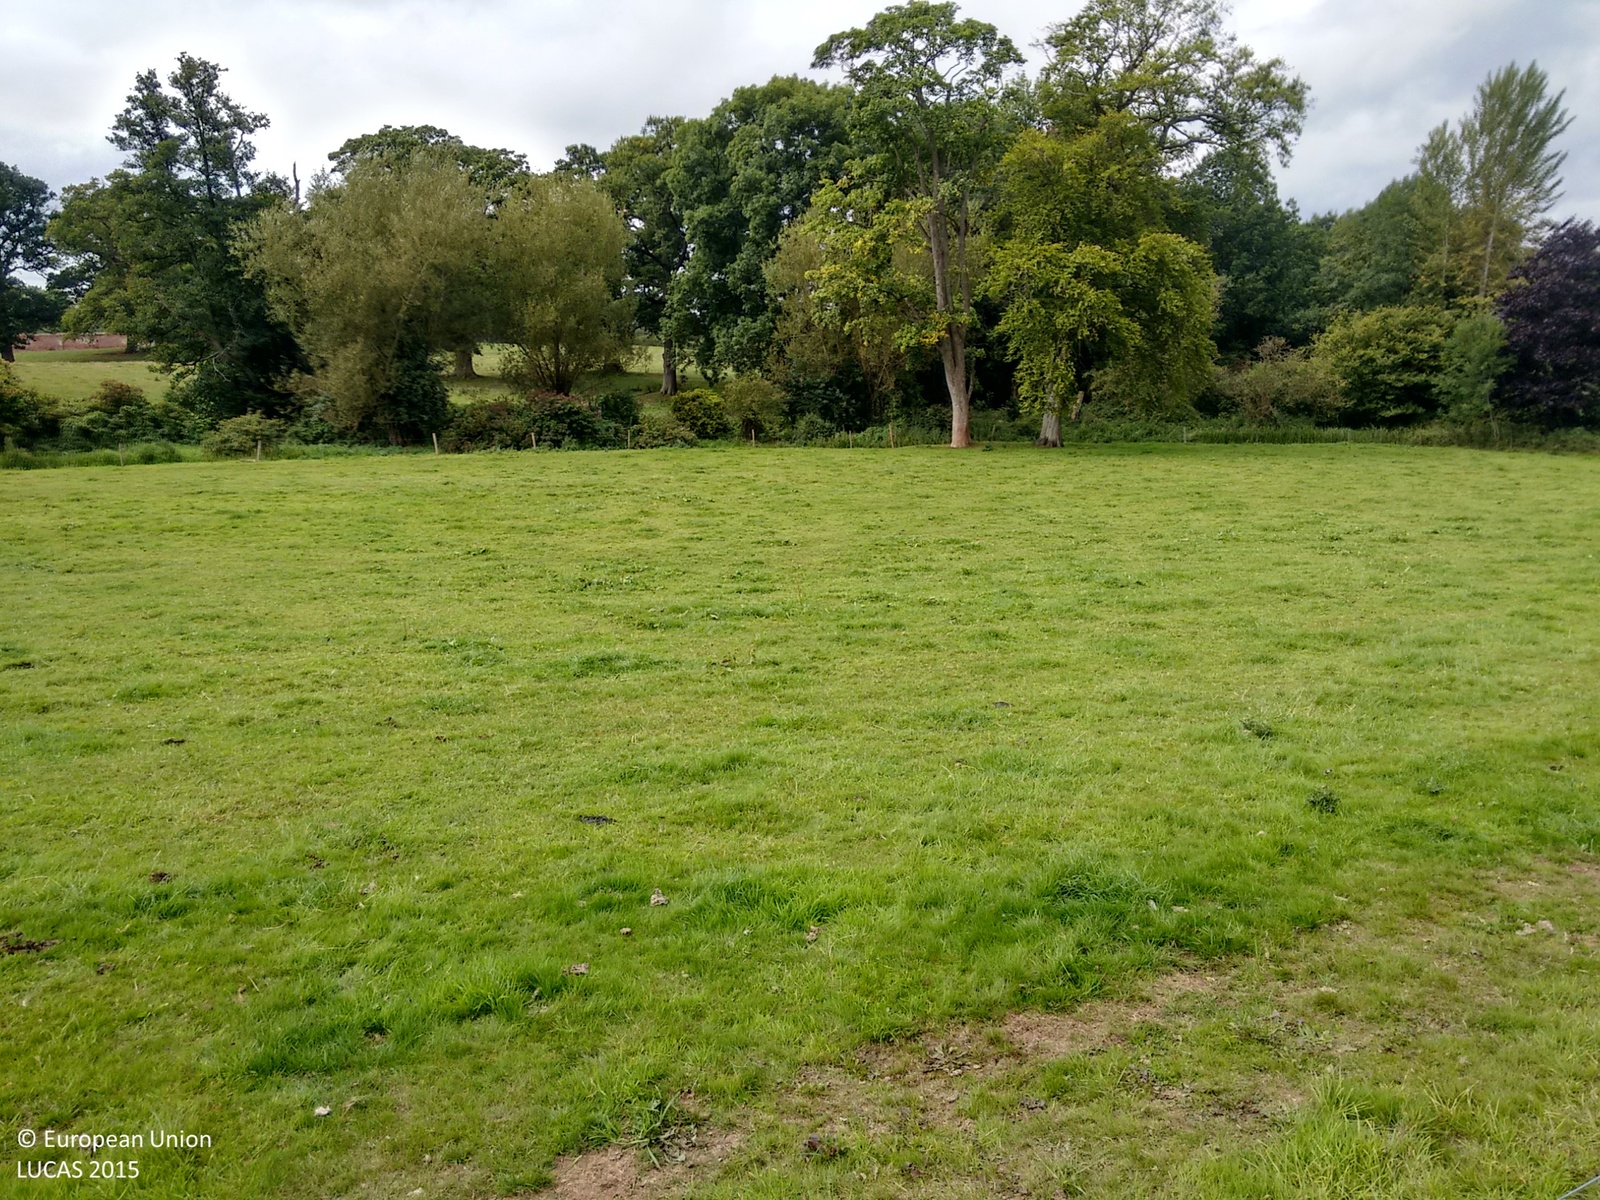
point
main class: Grassland
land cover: Grassland without tree/shrub cover
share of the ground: > 75 %
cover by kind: herbaceous plants 100 %
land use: Agriculture (excluding fallow land and kitchen gardens)
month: September
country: GB
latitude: 52.8809
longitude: -2.9876
